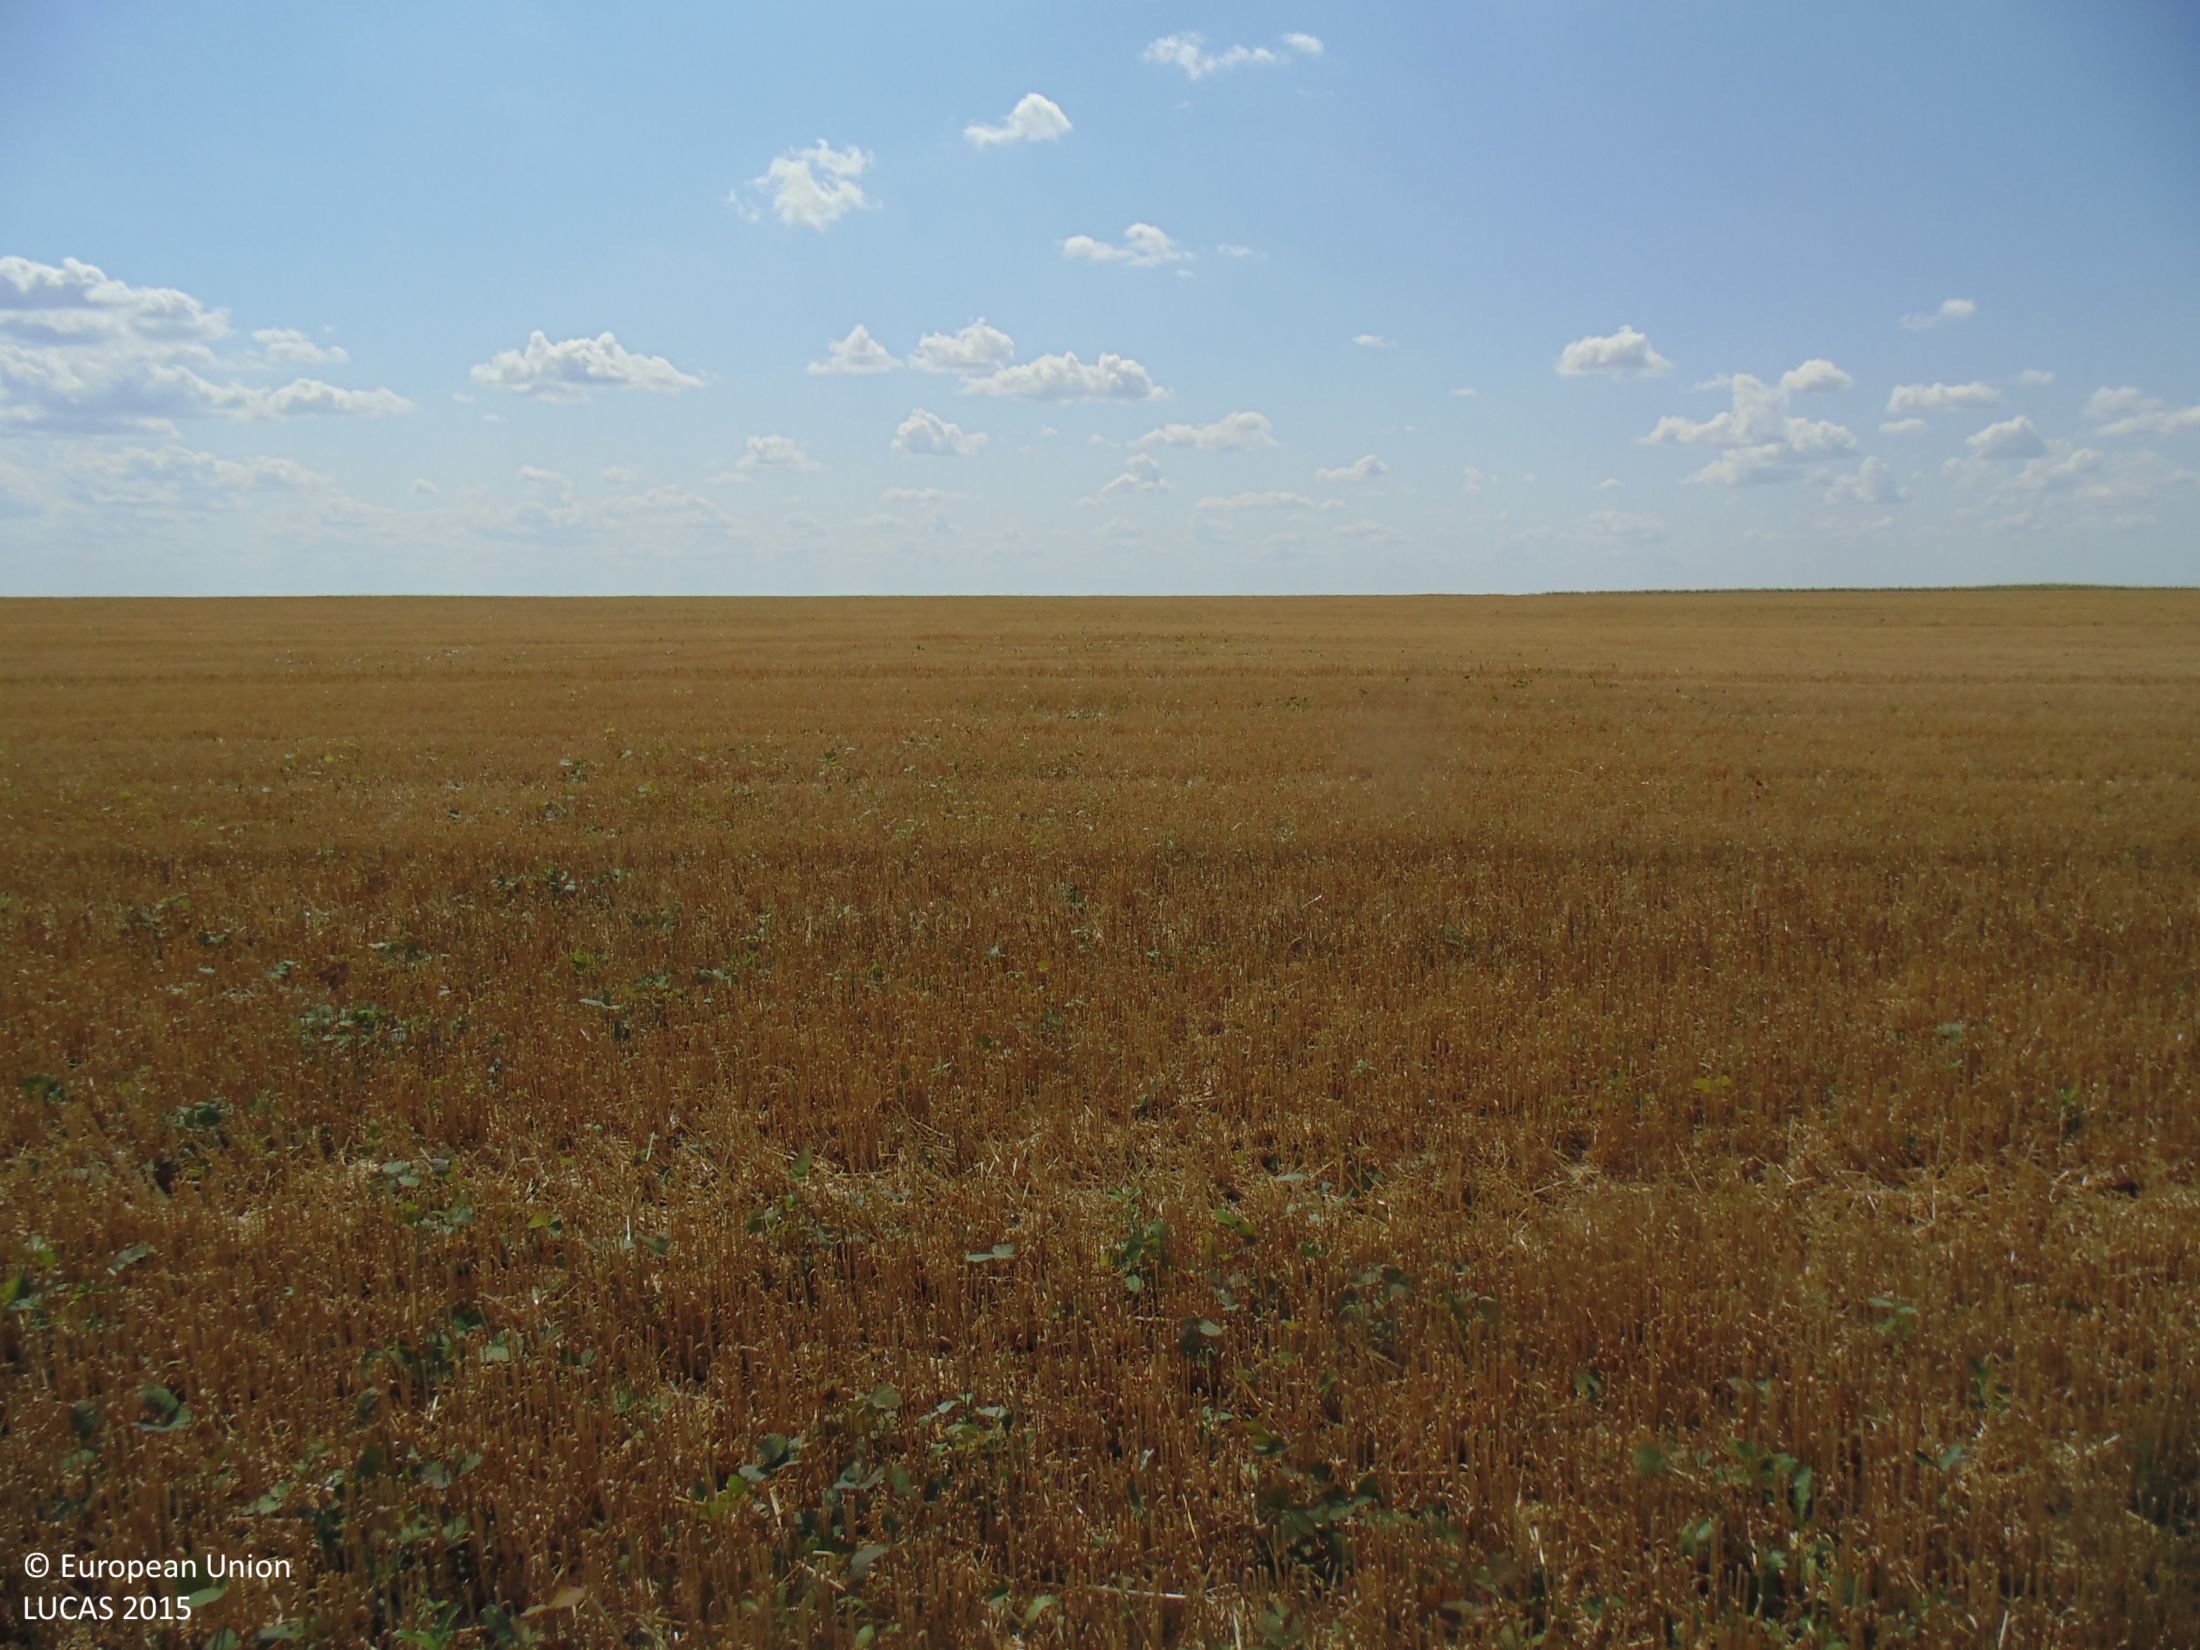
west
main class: Cropland
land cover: Common wheat
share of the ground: > 75 %
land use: Agriculture (excluding fallow land and kitchen gardens)
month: July
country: BG
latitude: 43.5685
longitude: 27.7071
